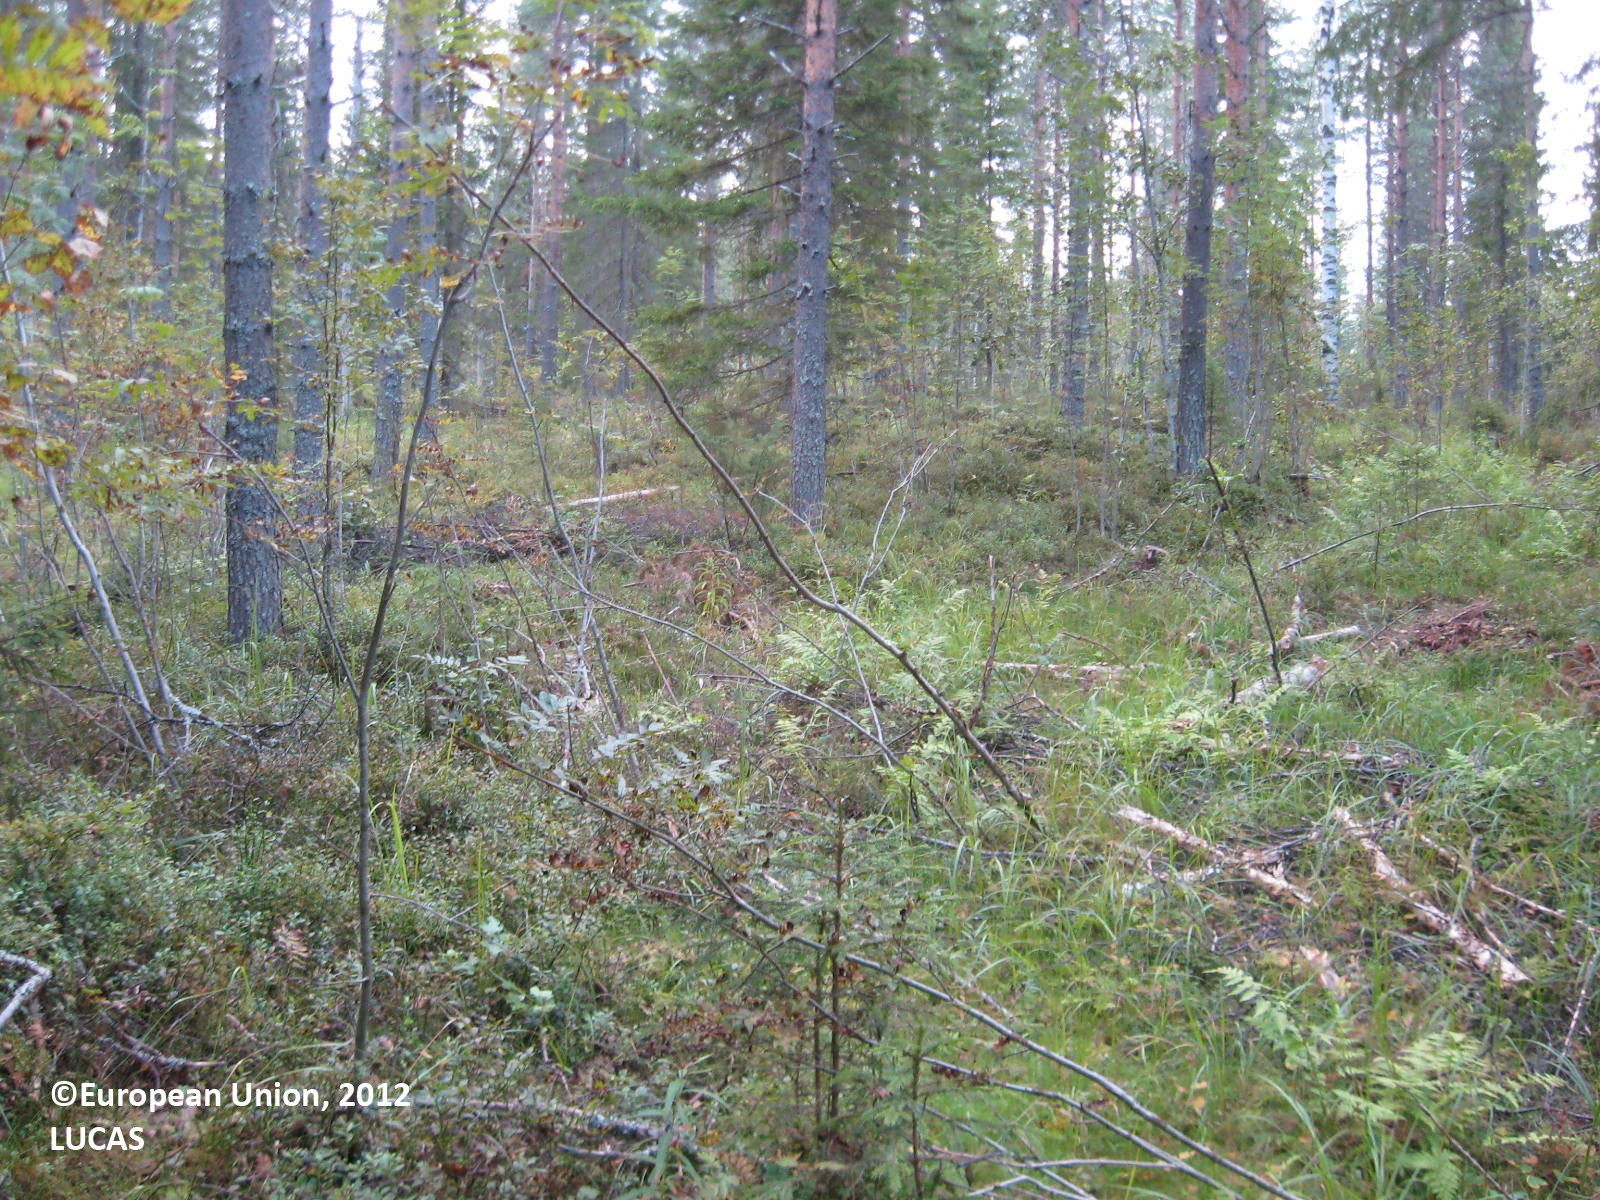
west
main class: Woodland
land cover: Other coniferous woodland
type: boreal forest
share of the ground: 50 - 75 %
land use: Forestry
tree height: > 5 m
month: August
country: FI
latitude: 63.7344
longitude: 29.3162
